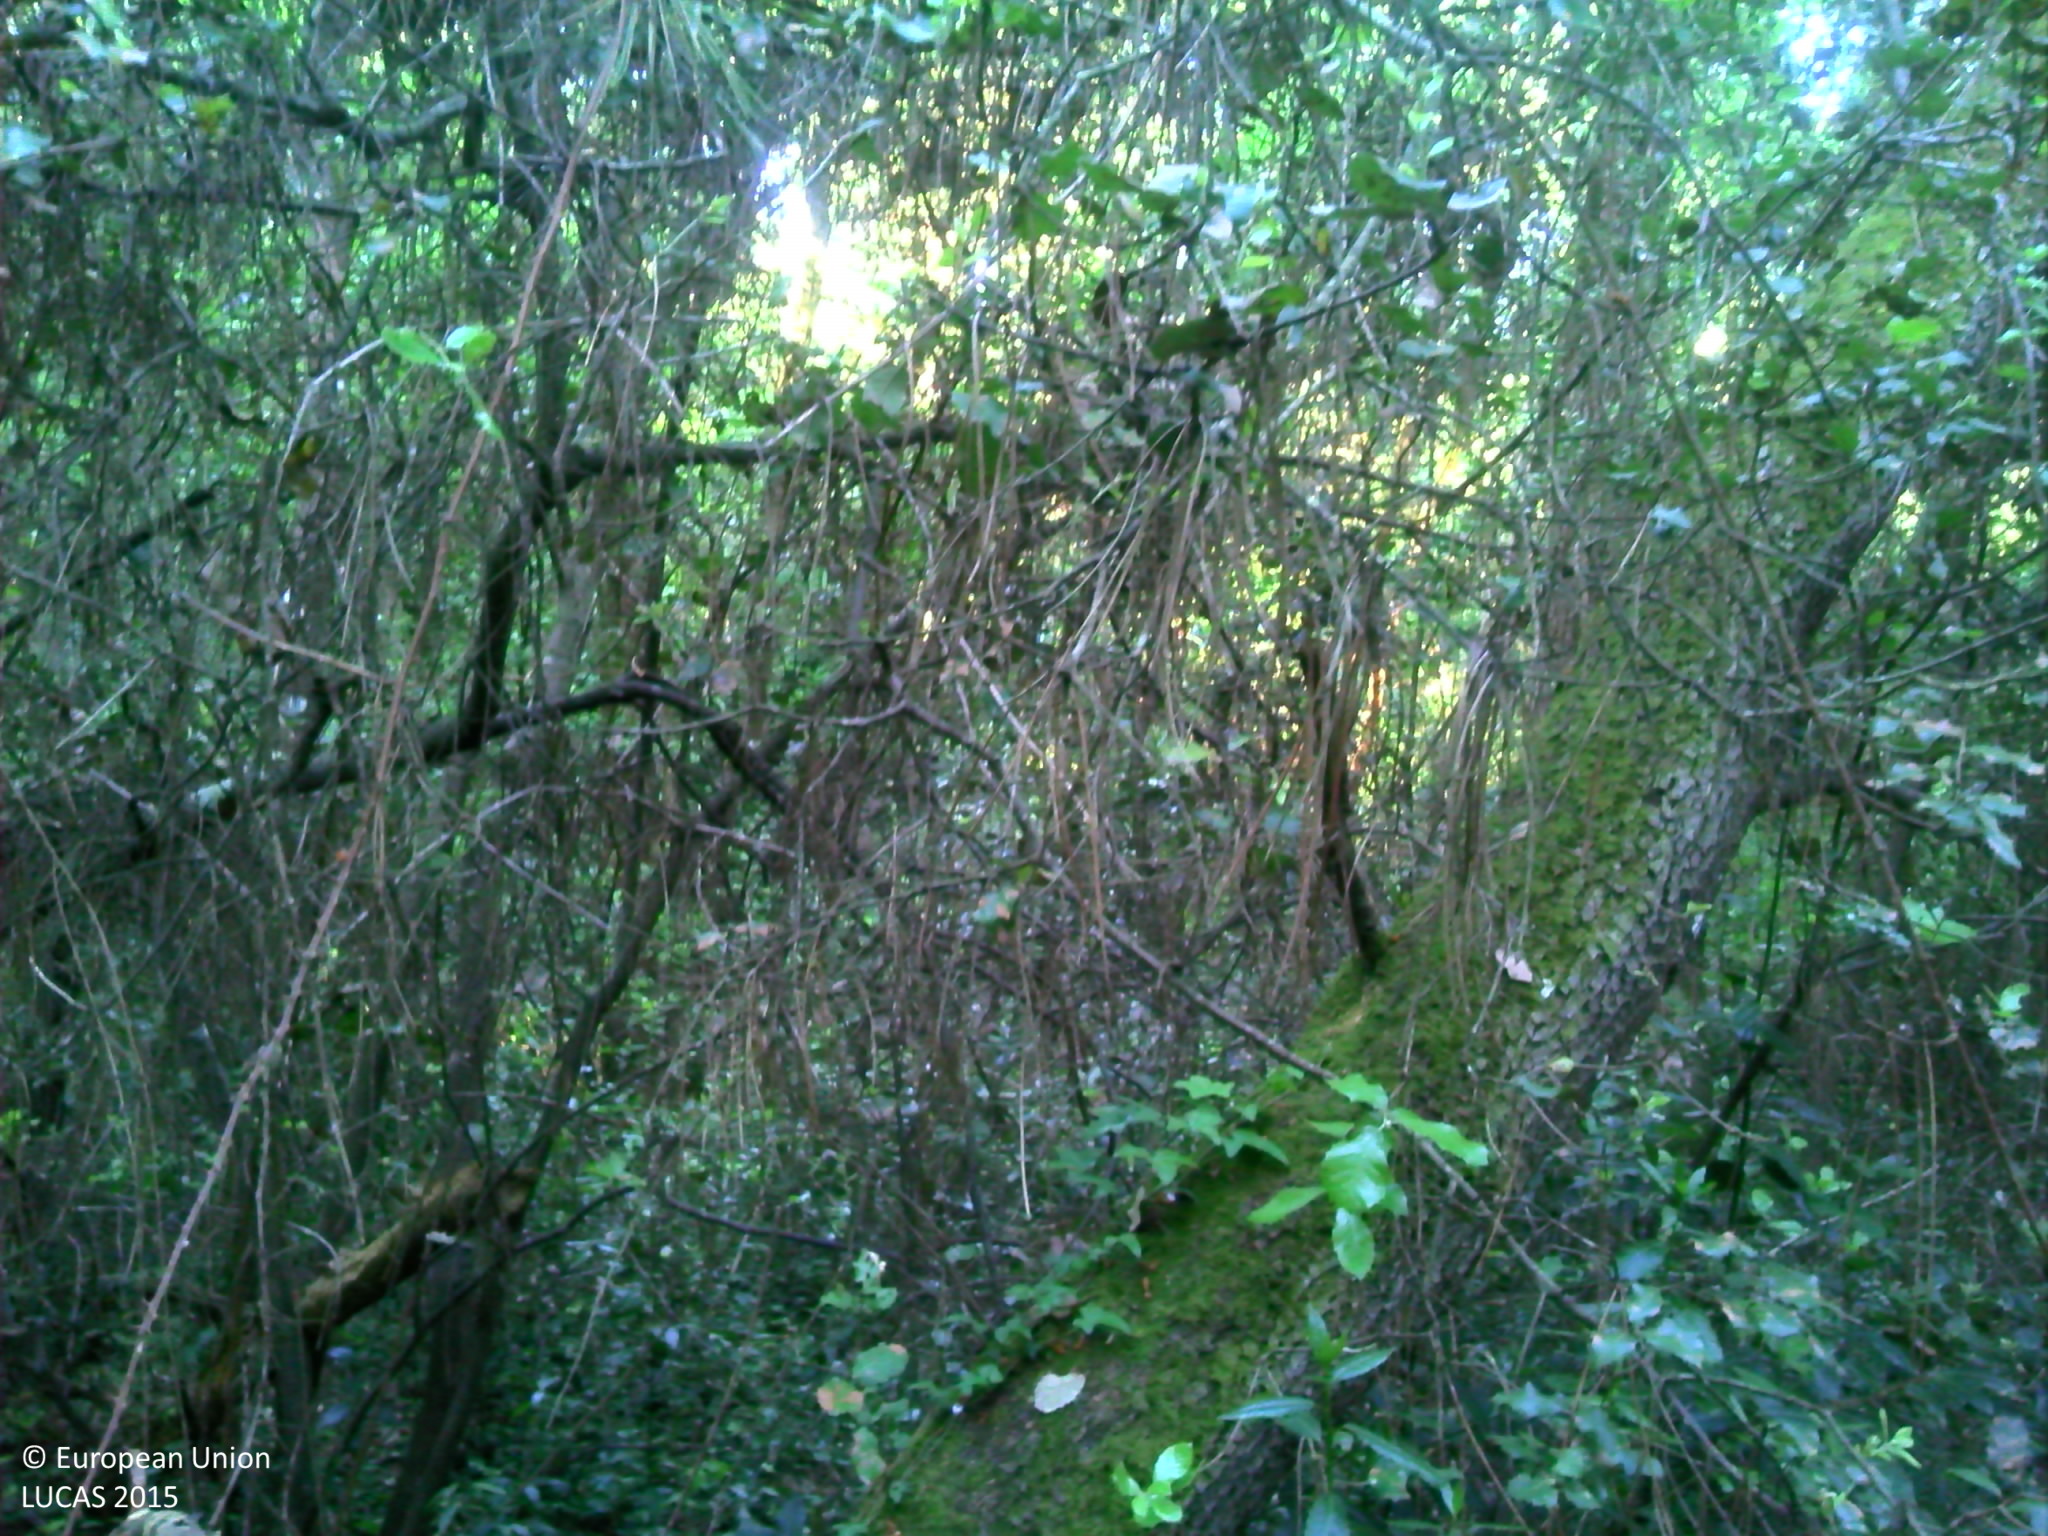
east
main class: Woodland
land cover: Pine dominated mixed woodland
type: coniferous forest of the mediterranean region
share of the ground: > 75 %
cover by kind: coniferous forest trees 75 %, broadleaved forest trees 25 %
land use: Forestry
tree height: > 5 m
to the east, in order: Pine dominated mixed woodland; Fences; Artificial constructions in urban areas
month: May
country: FR
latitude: 45.8318
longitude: -1.2179
